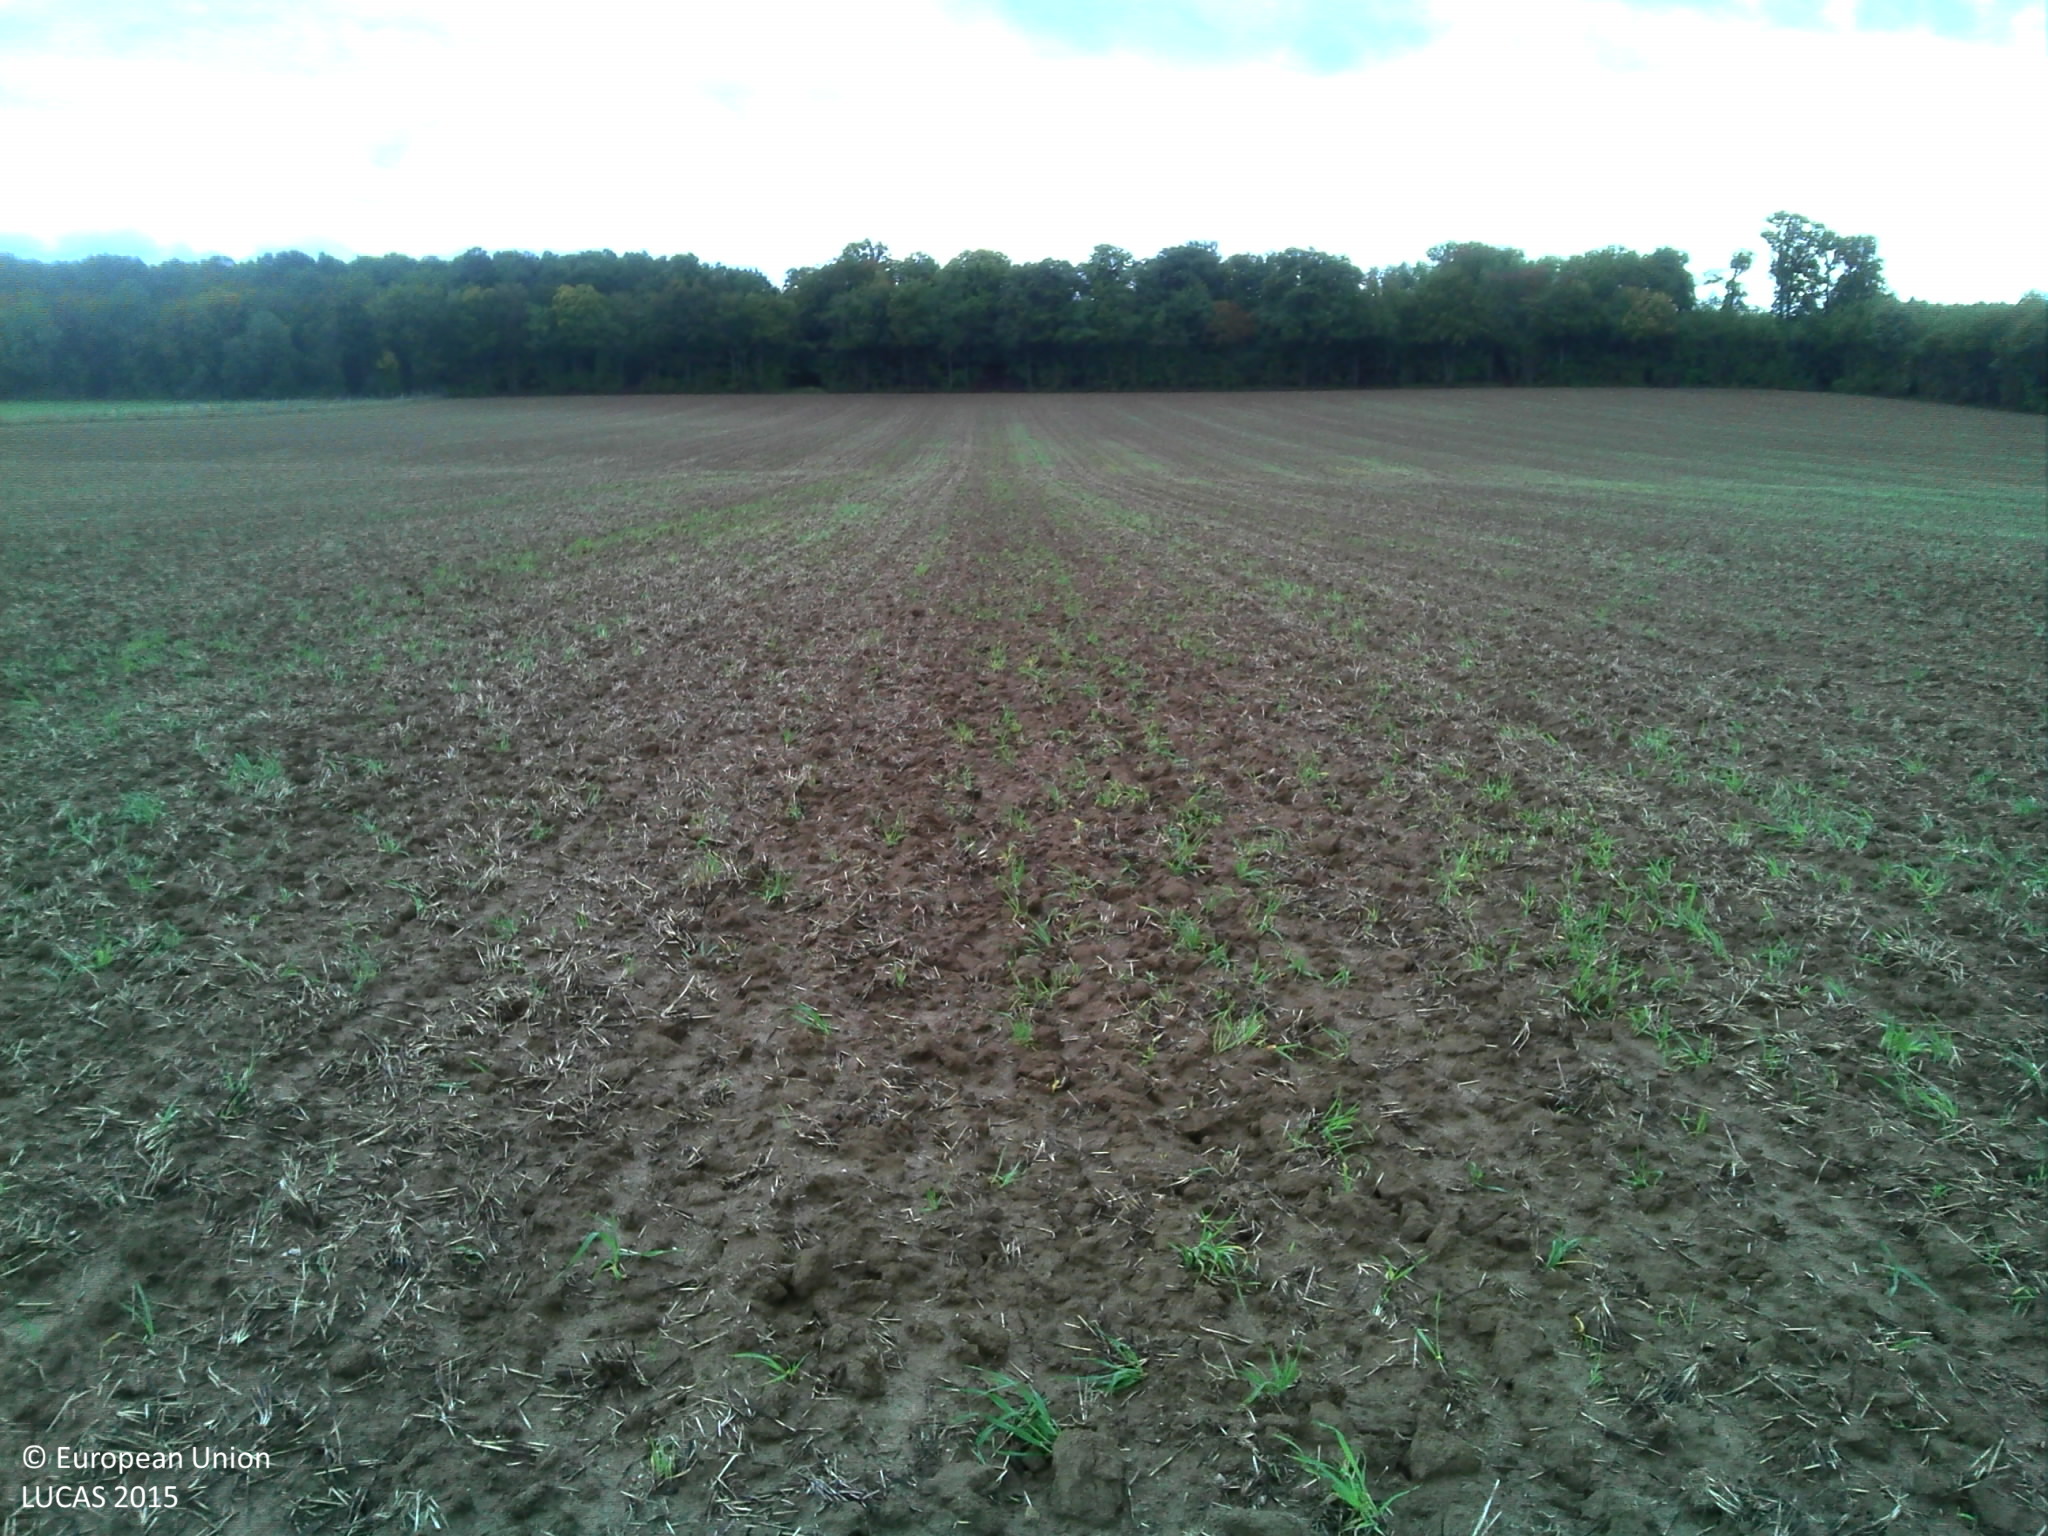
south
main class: Cropland
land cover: Common wheat
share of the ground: 25 - 50 %
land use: Agriculture (excluding fallow land and kitchen gardens)
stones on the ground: < 10 %
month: October
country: FR
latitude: 48.2923
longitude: 4.2955
